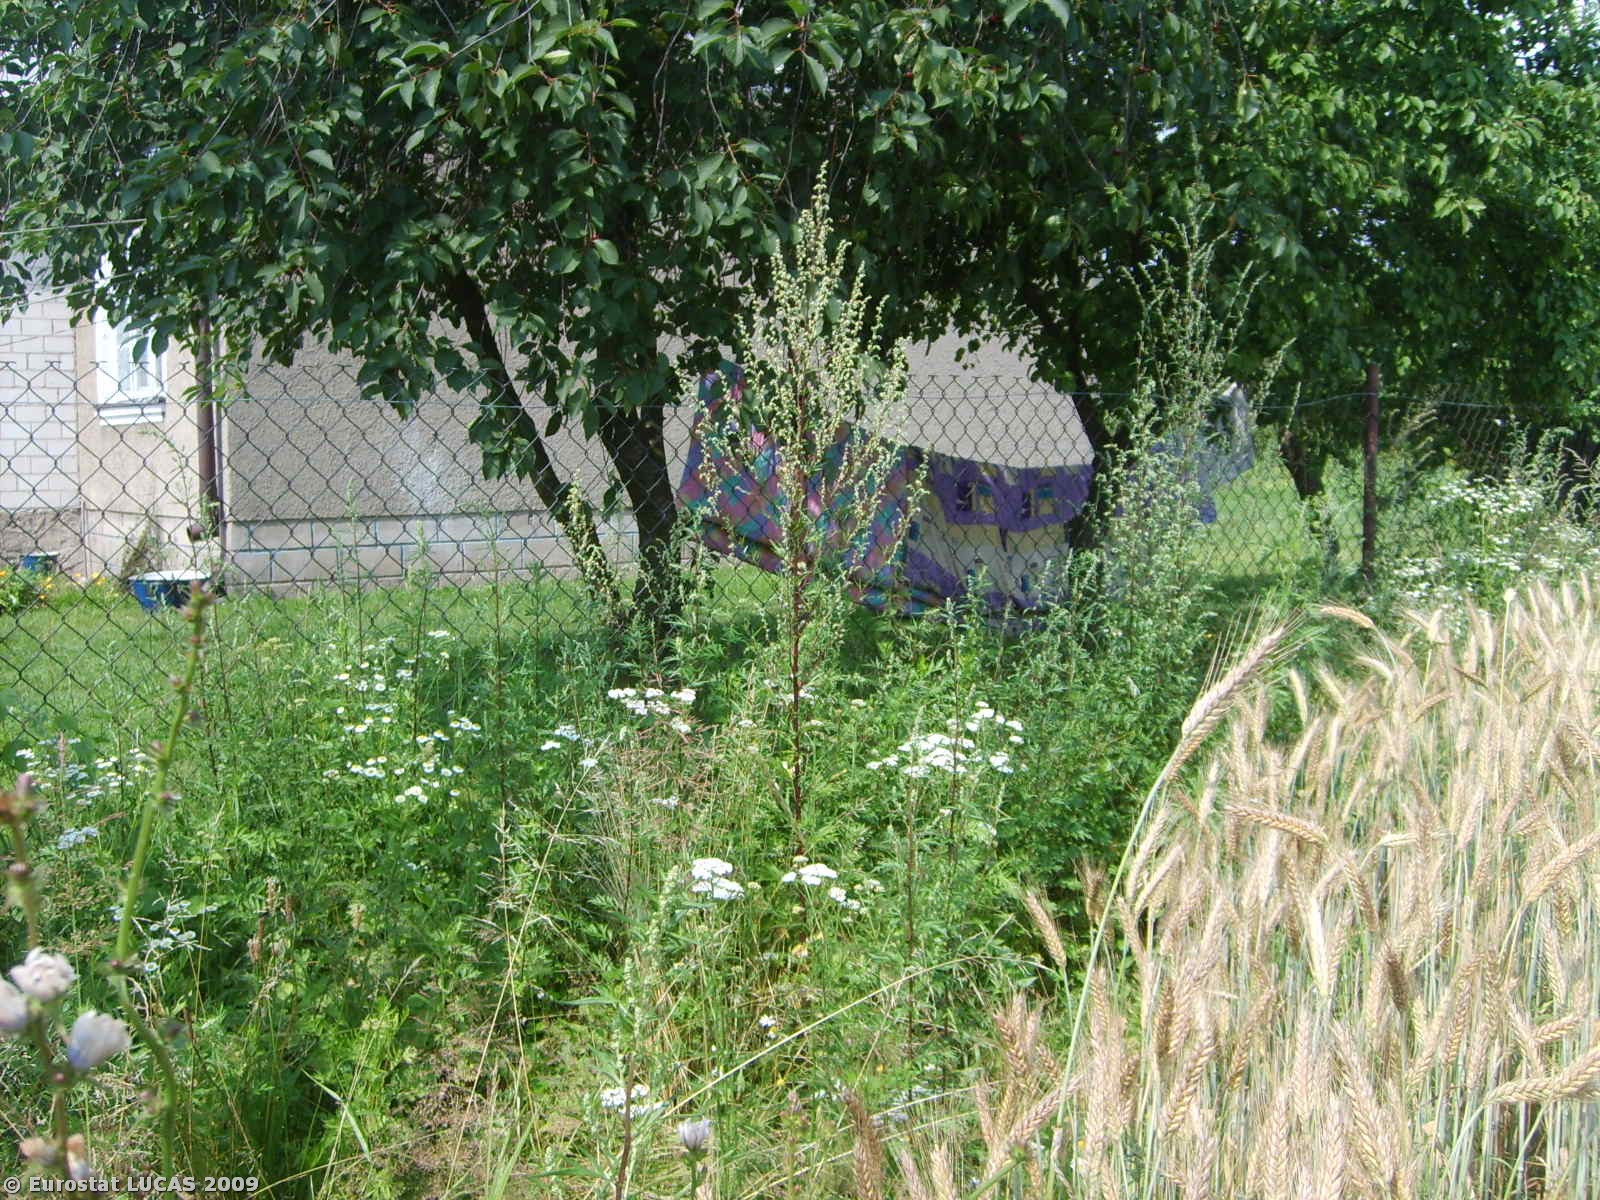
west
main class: Cropland
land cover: Triticale
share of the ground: > 75 %
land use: Agriculture (excluding fallow land and kitchen gardens)
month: July
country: PL
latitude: 52.0945
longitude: 21.6280
